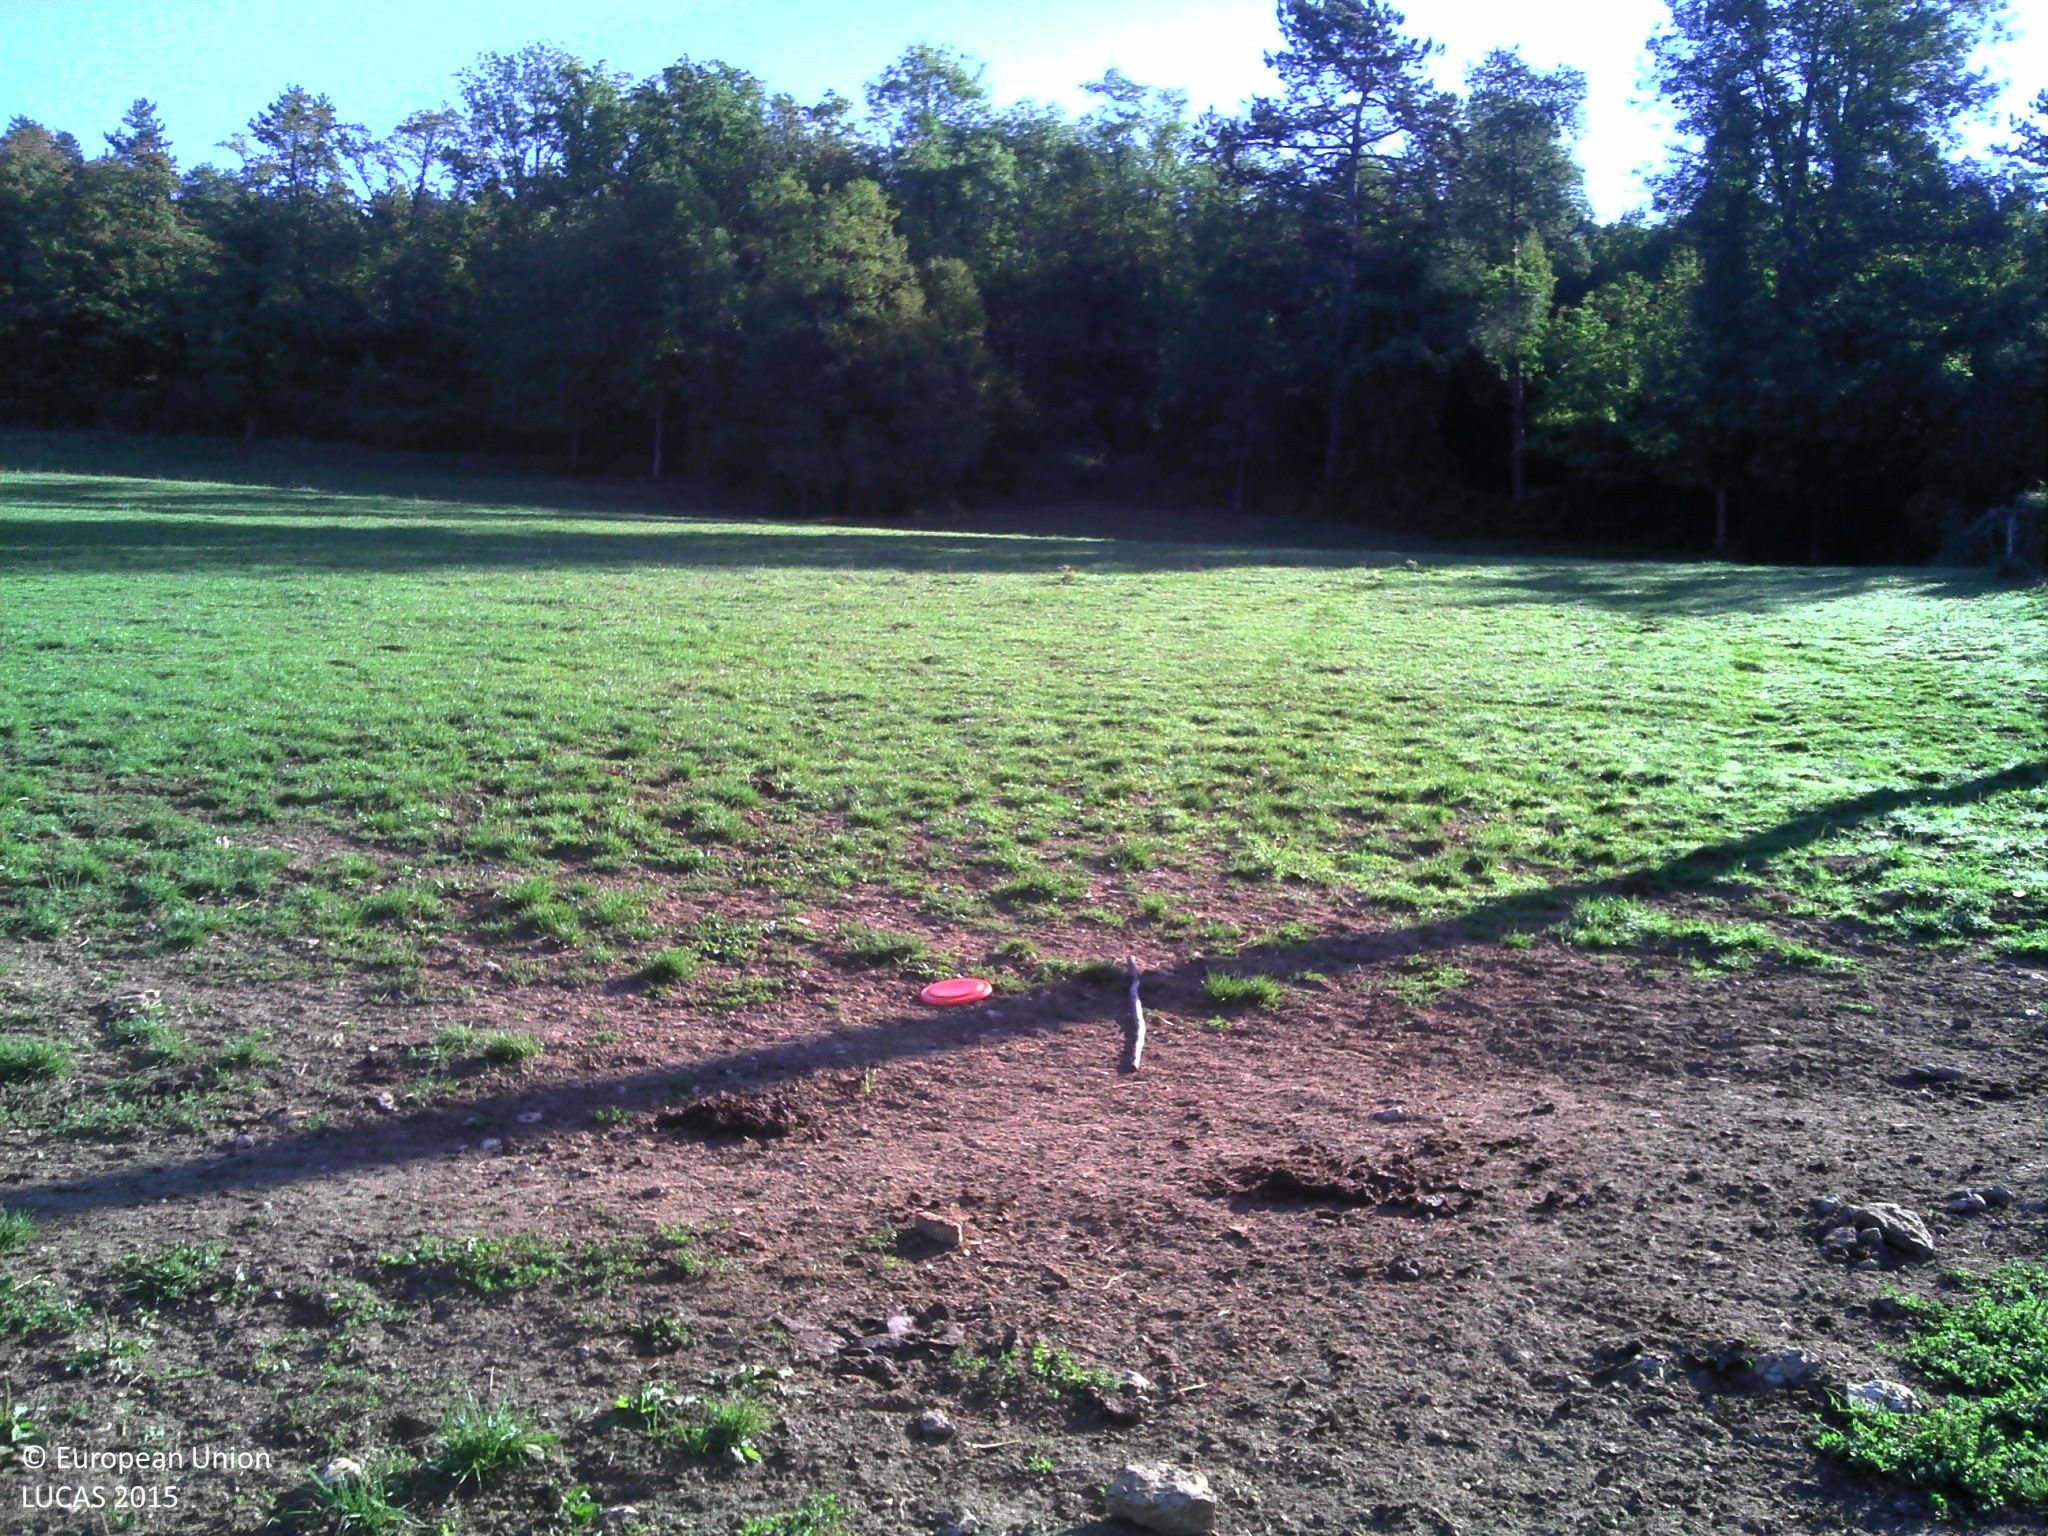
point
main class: Grassland
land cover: Grassland without tree/shrub cover
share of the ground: > 75 %
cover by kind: herbaceous plants 90 %, unconsolidated bare surface 10 %
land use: Agriculture (excluding fallow land and kitchen gardens)
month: September
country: FR
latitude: 47.6080
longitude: 4.3183
